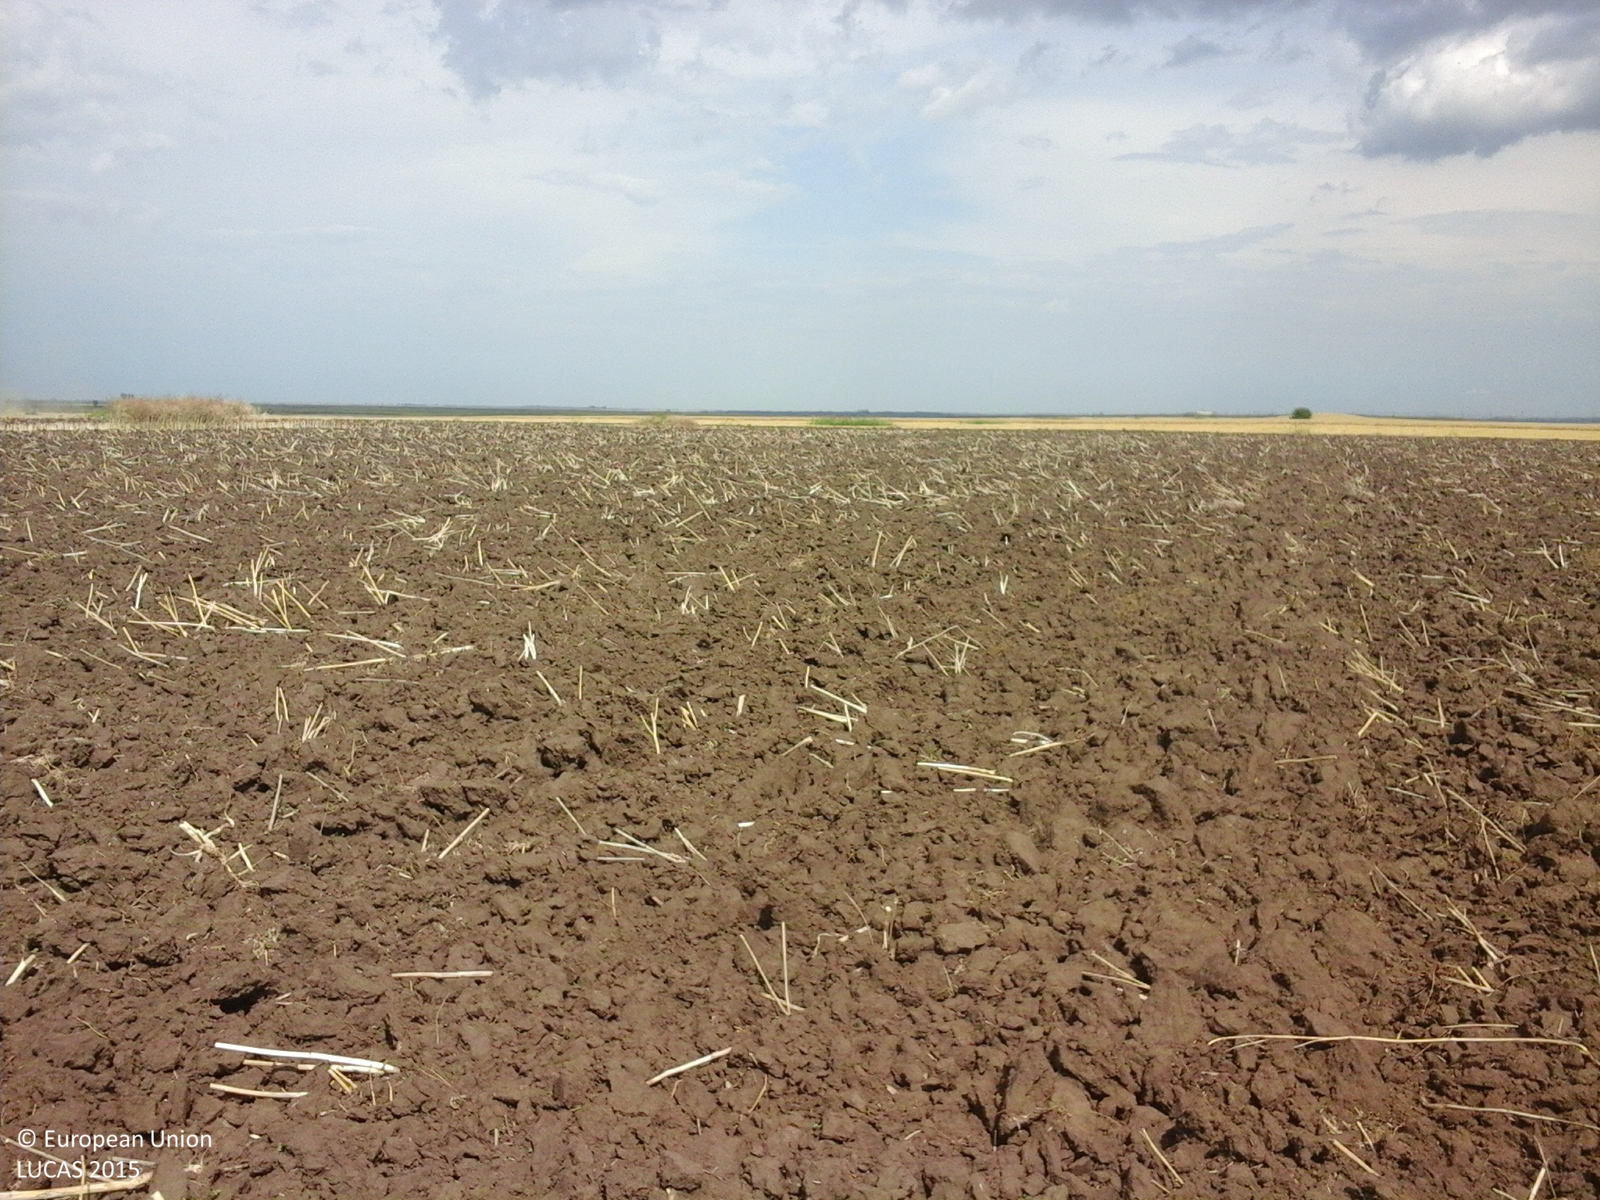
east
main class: Cropland
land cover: Rape and turnip rape
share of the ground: < 10 %
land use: Agriculture (excluding fallow land and kitchen gardens)
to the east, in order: Rape and turnip rape; Tracks; Common wheat
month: July
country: RO
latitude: 43.8088
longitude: 24.3197
